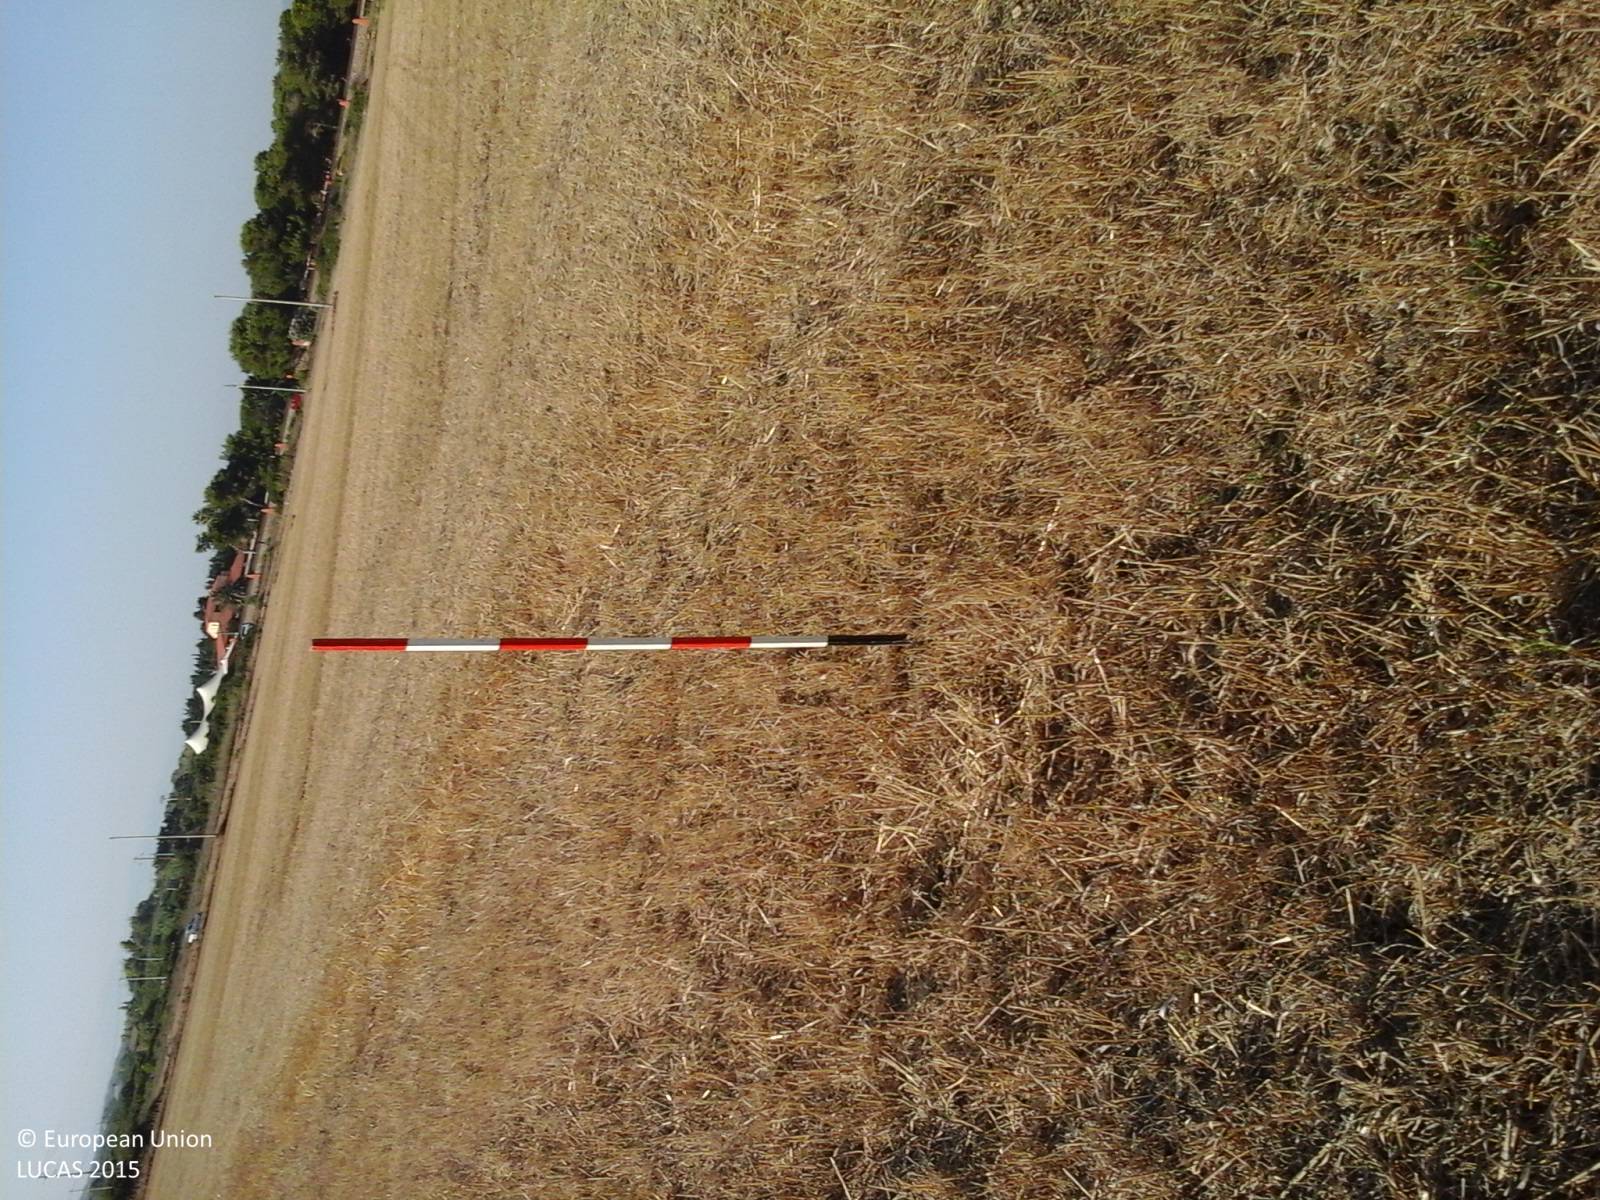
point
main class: Cropland
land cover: Barley
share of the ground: < 10 %
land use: Agriculture (excluding fallow land and kitchen gardens)
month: August
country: IT
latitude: 40.0197
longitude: 8.4501
